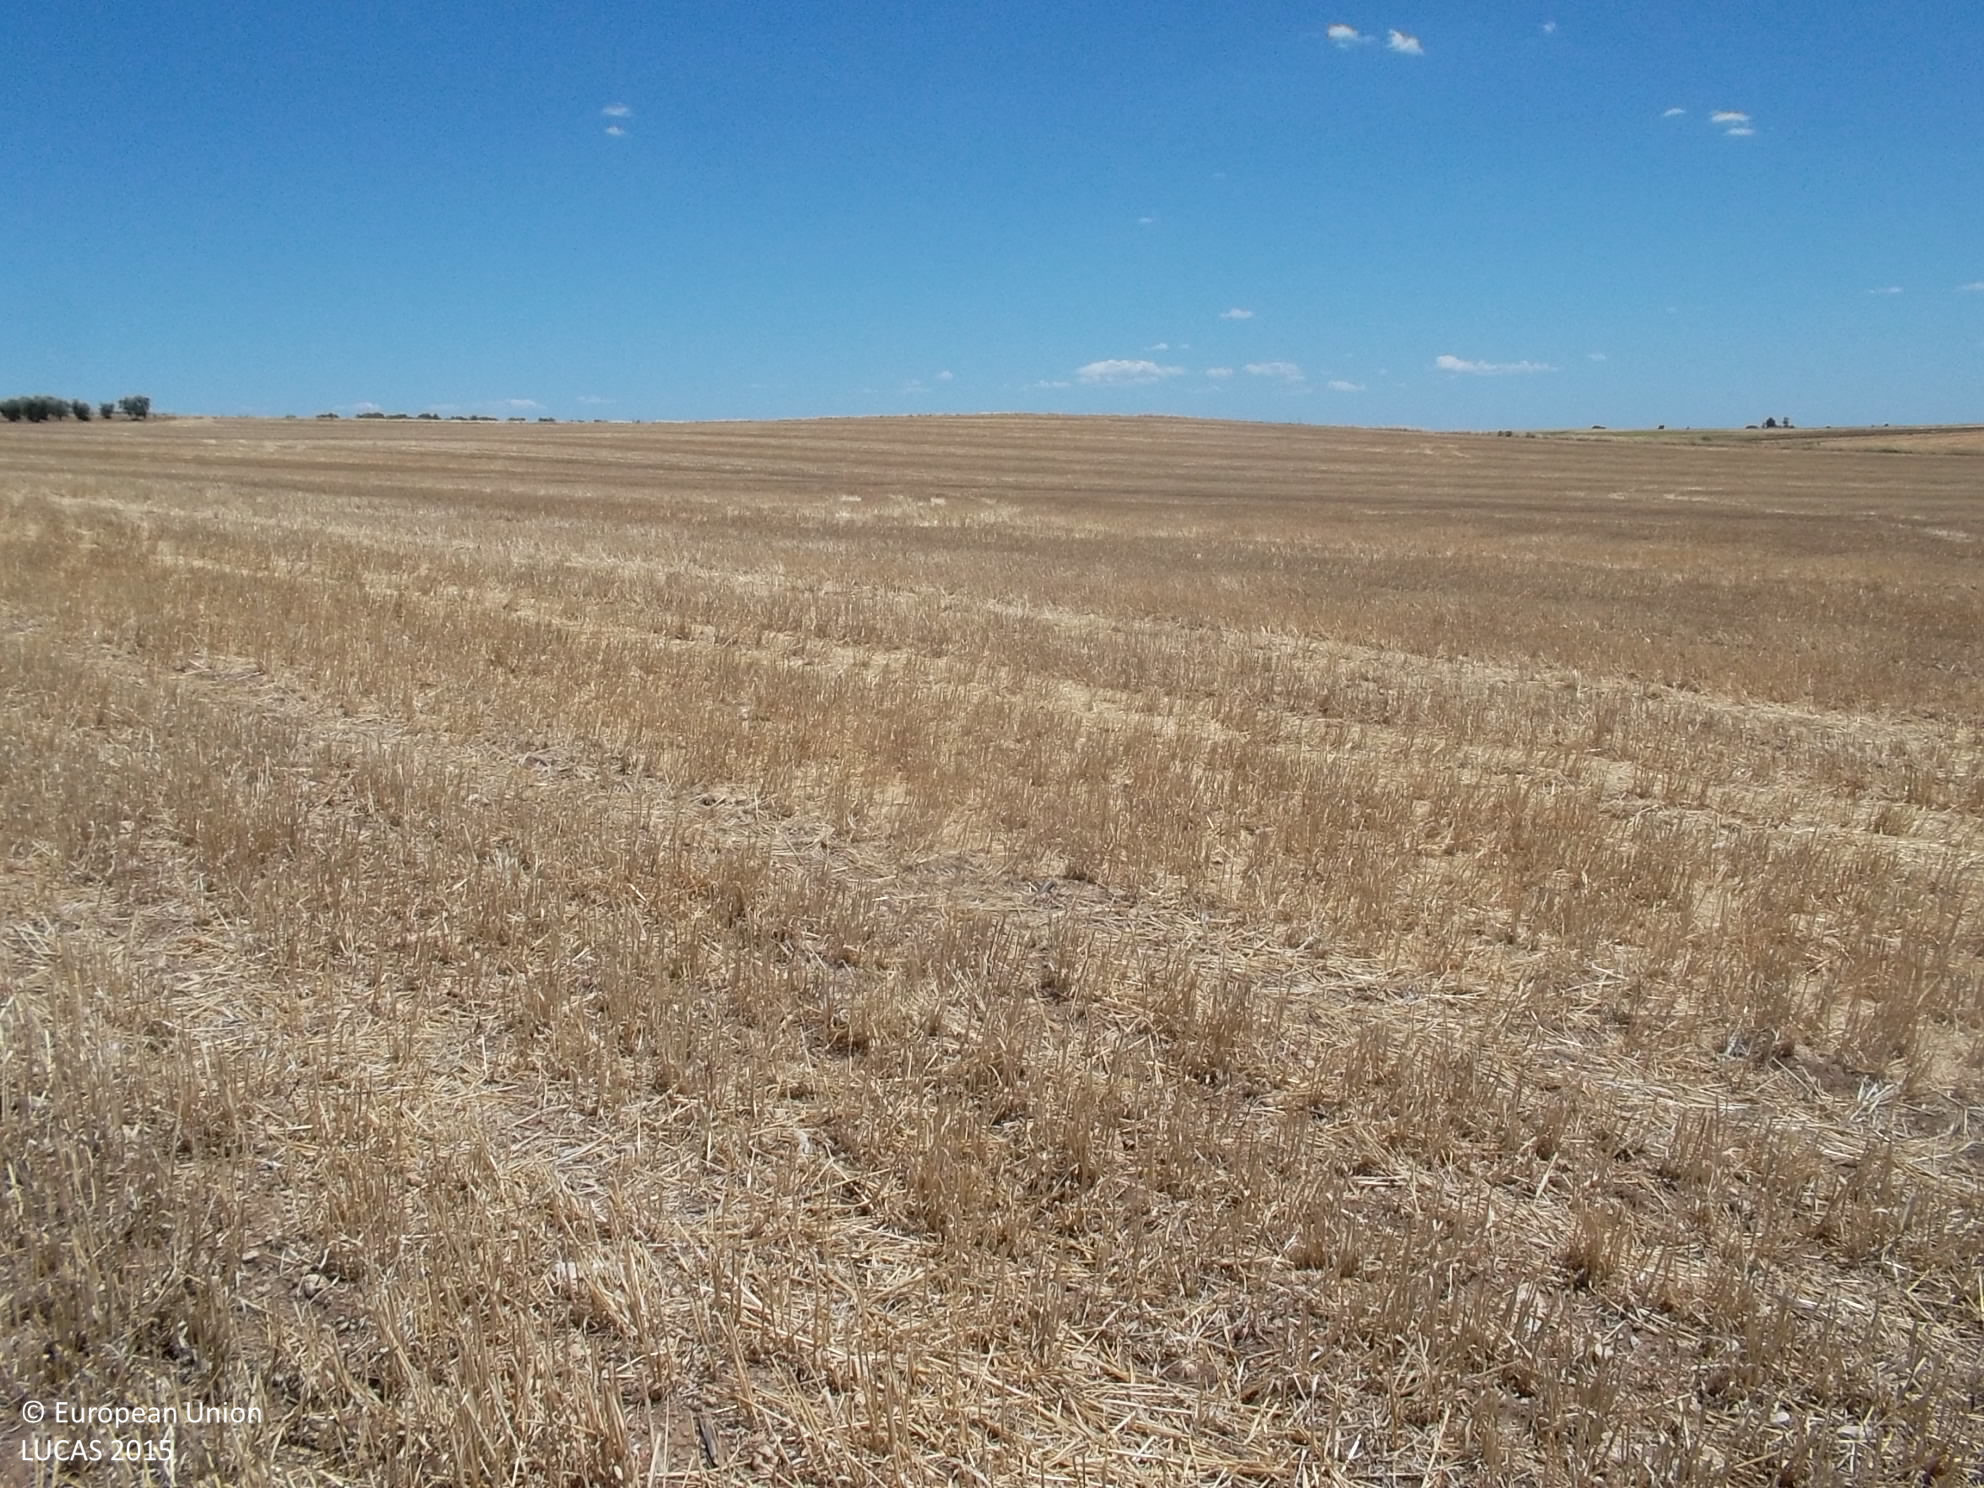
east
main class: Cropland
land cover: Barley
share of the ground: < 10 %
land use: Agriculture (excluding fallow land and kitchen gardens)
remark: Harvested field
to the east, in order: Barley
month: July
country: ES
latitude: 38.3390
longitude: -5.7684
